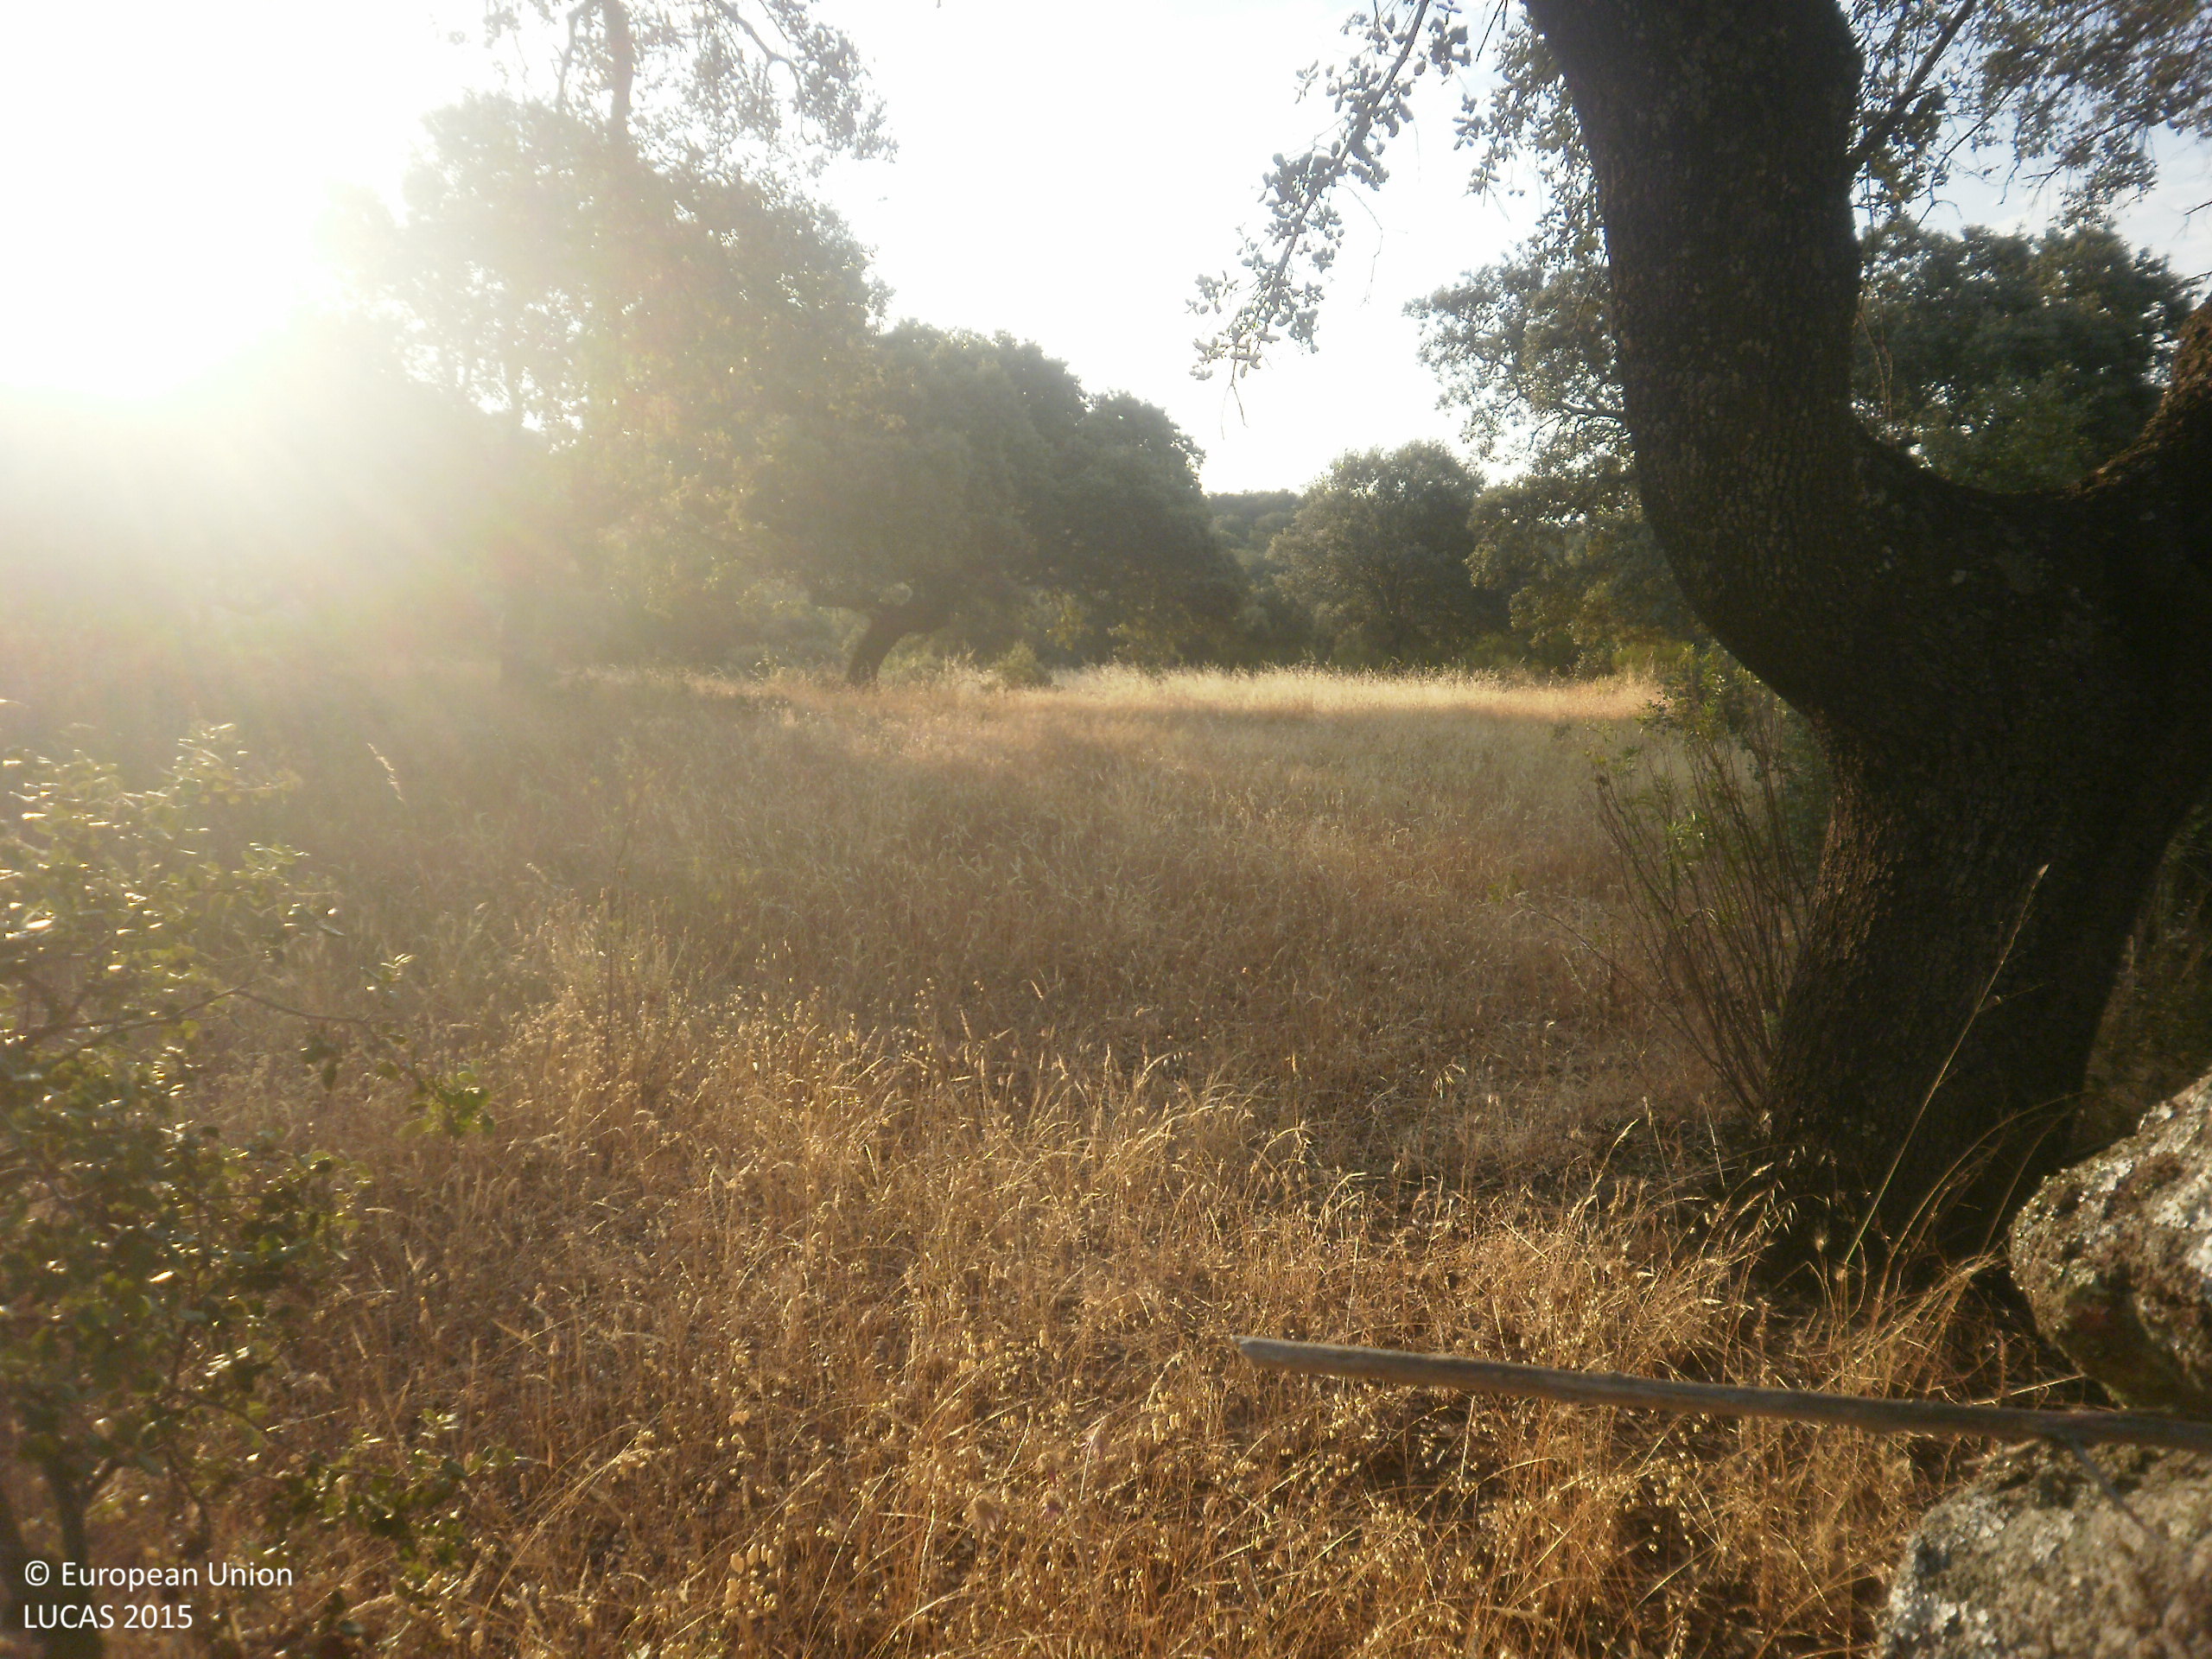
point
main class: Woodland
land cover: Broadleaved woodland
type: broadleaved evergreen forest
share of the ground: 50 - 75 %
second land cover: Grassland without tree/shrub cover
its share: 50 - 75 %
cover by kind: herbaceous plants 70 %, broadleaved forest trees 20 %, shrubs 10 %
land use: Forestry
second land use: Agriculture (excluding fallow land and kitchen gardens)
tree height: > 5 m
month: June
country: ES
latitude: 39.2665
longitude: -5.9464
